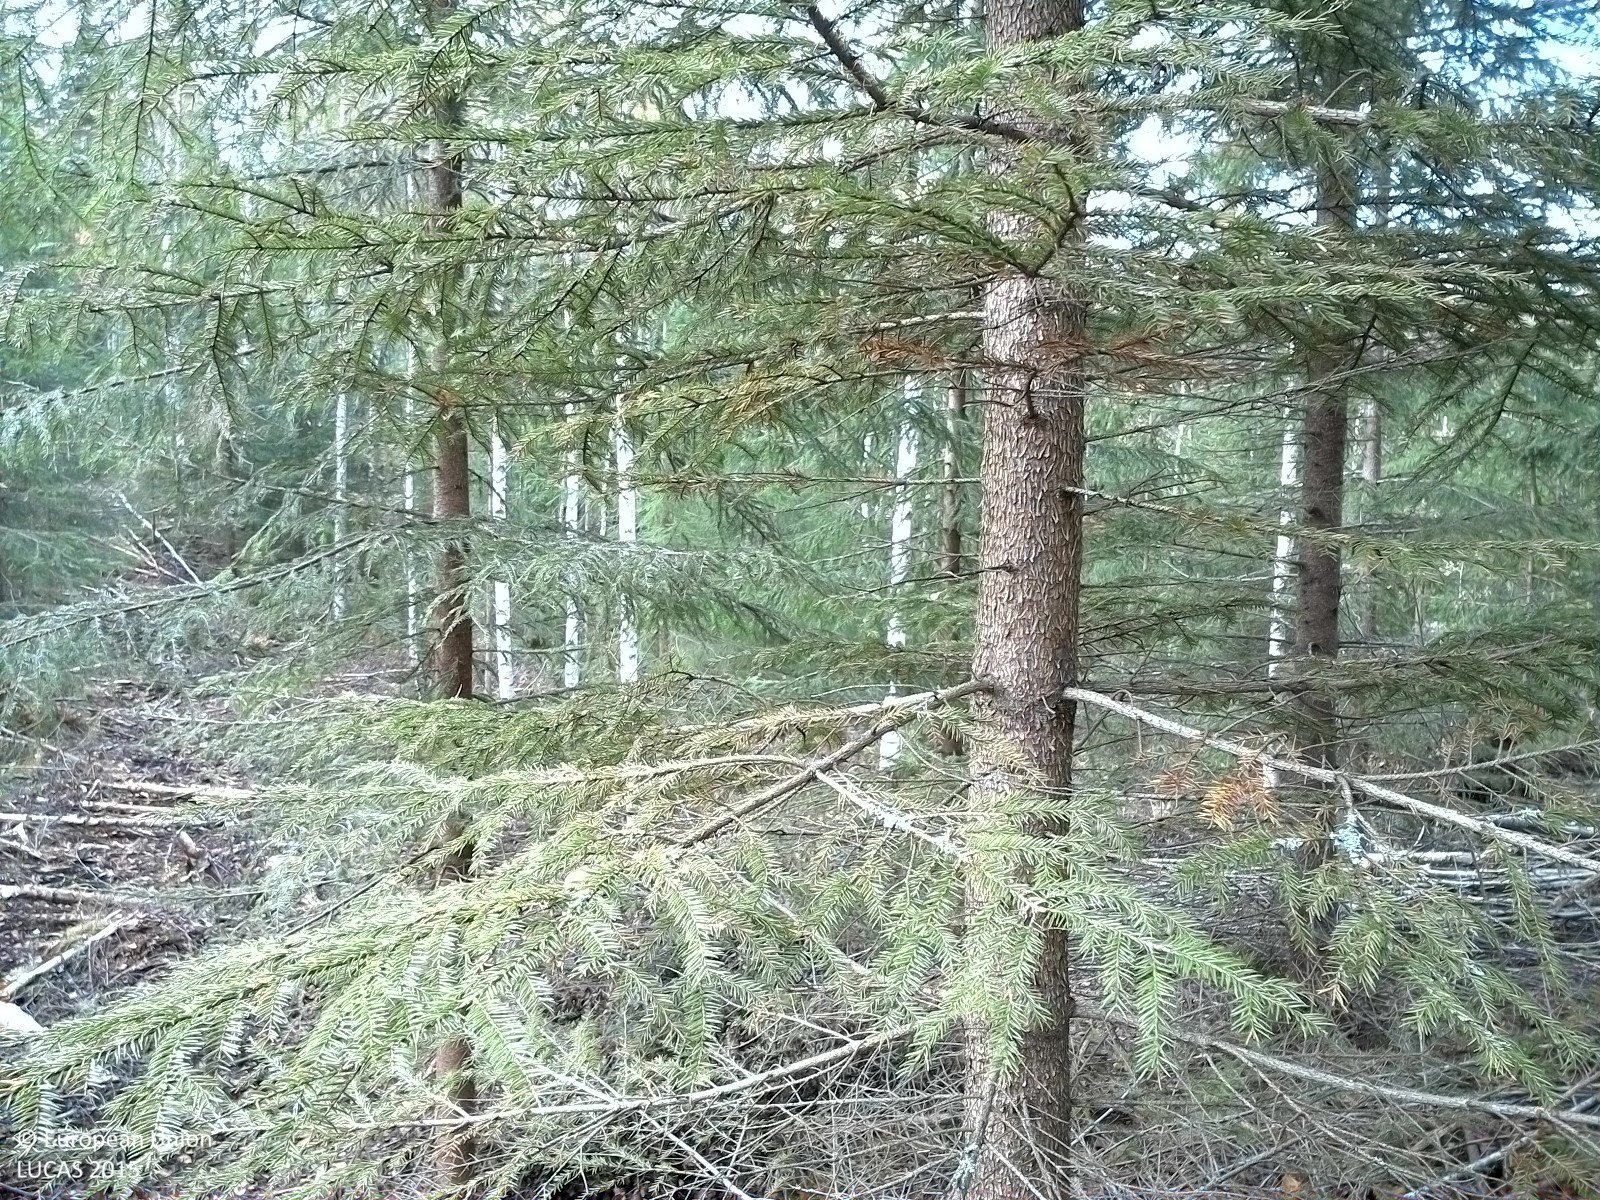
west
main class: Woodland
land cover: Spruce dominated coniferous woodland
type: boreal forest
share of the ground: > 75 %
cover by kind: coniferous forest trees 60 %, broadleaved forest trees 15 %, herbaceous plants 5 %, lichens and mosses 5 %
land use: Forestry
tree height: > 5 m
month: September
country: SE
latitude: 62.3286
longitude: 17.2576
